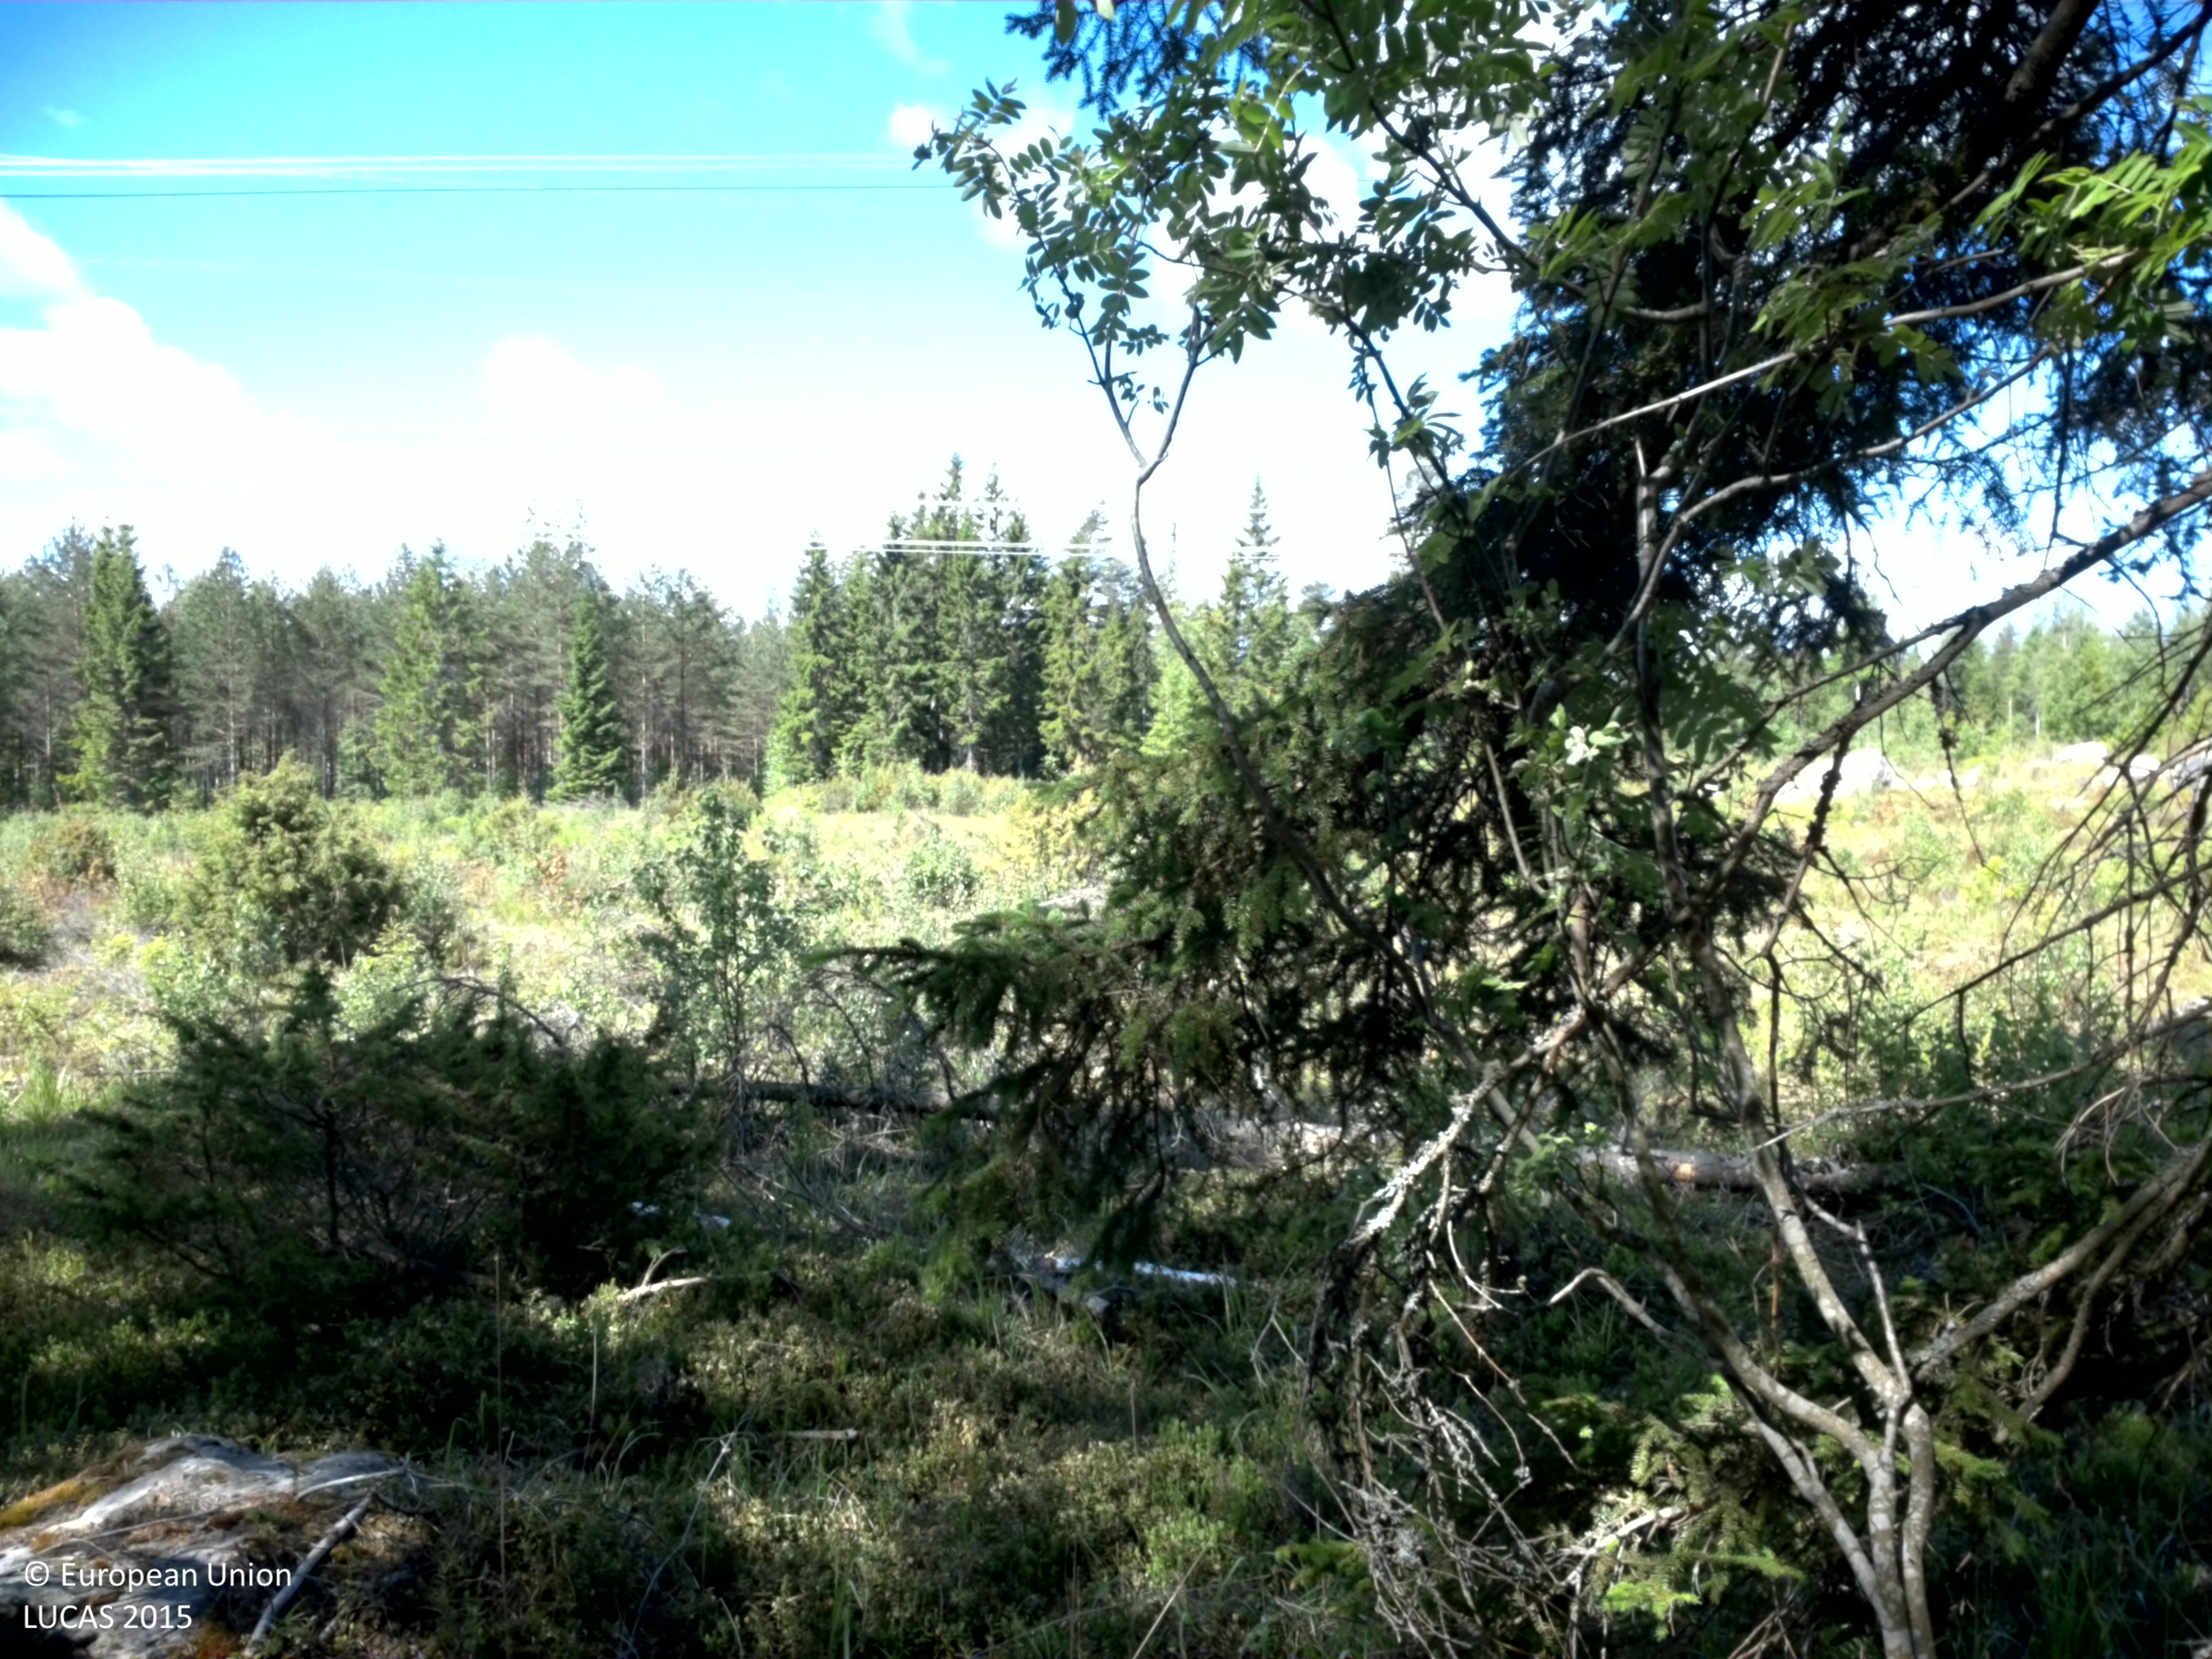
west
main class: Woodland
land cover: Spruce dominated mixed woodland
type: boreal forest
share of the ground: 50 - 75 %
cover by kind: coniferous forest trees 45 %, herbaceous plants 30 %, broadleaved forest trees 15 %, lichens and mosses 10 %
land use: Forestry
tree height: > 5 m
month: June
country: SE
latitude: 60.2554
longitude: 17.0922
